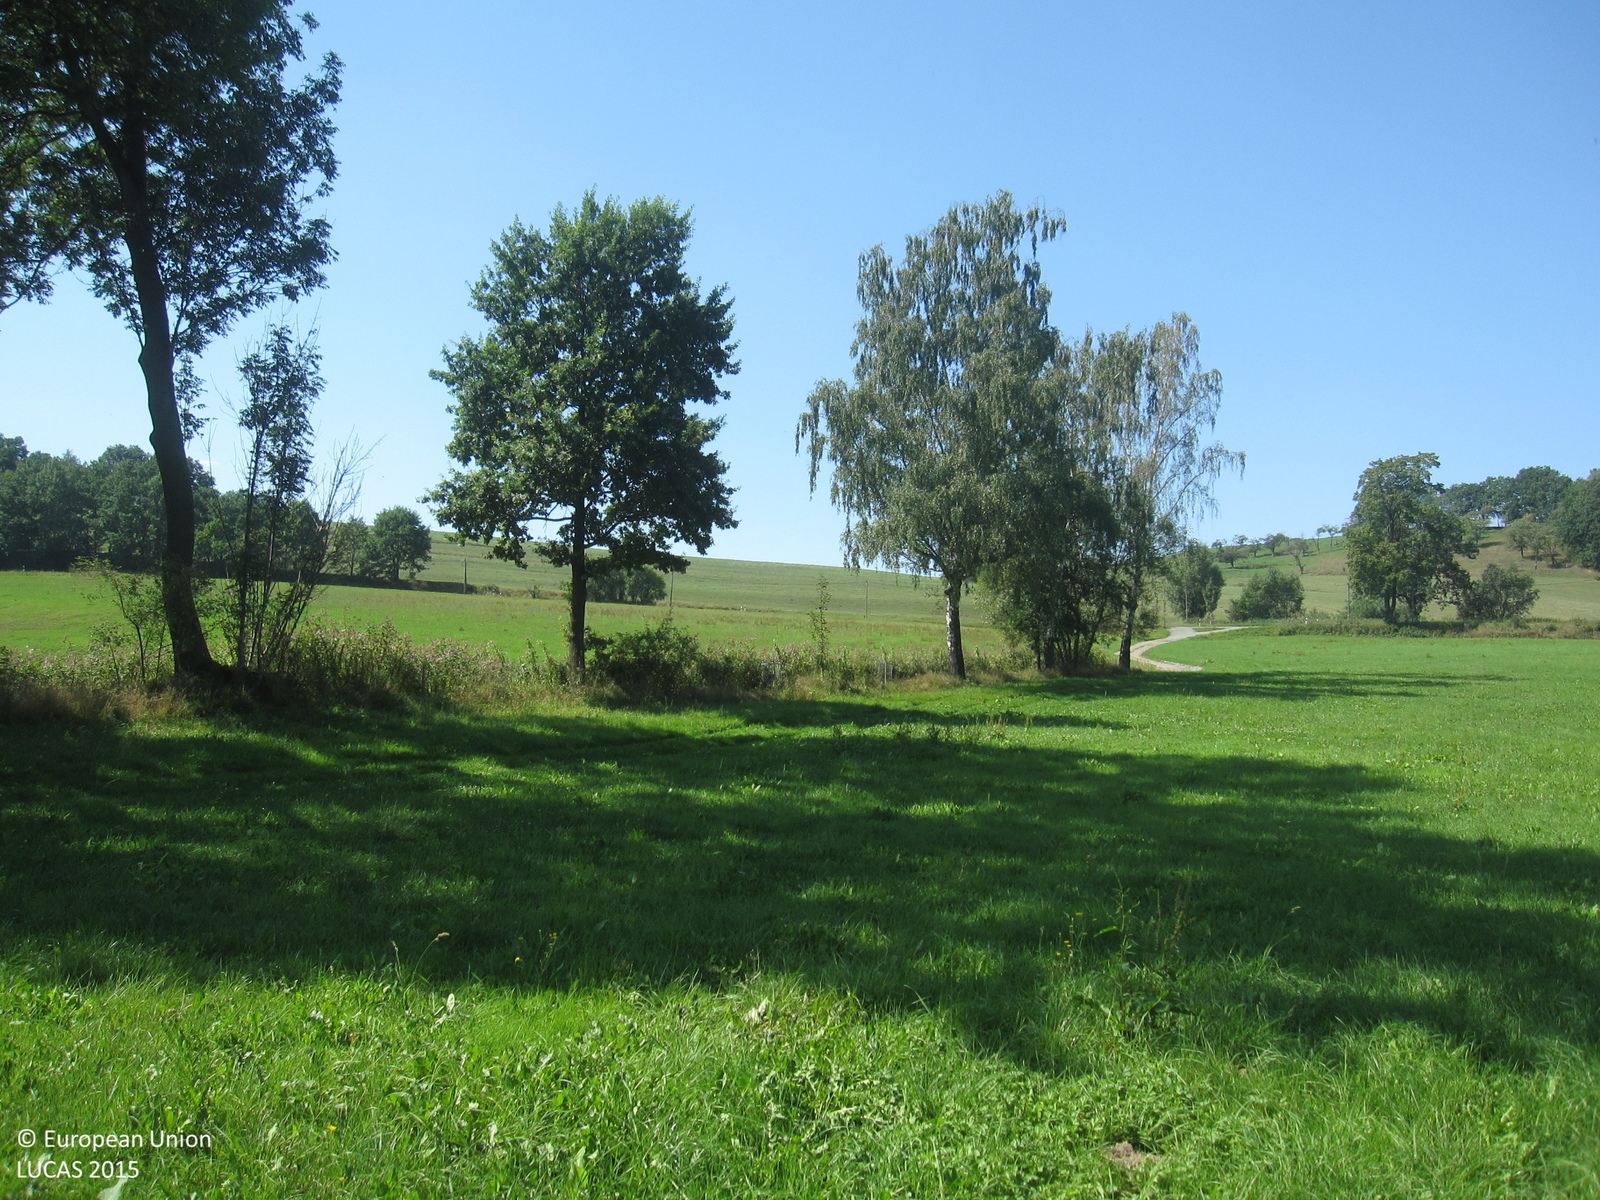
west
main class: Grassland
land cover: Grassland without tree/shrub cover
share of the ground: > 75 %
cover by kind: herbaceous plants 100 %
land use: Agriculture (excluding fallow land and kitchen gardens)
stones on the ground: < 10 %
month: August
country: DE
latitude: 50.7413
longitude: 12.0544
